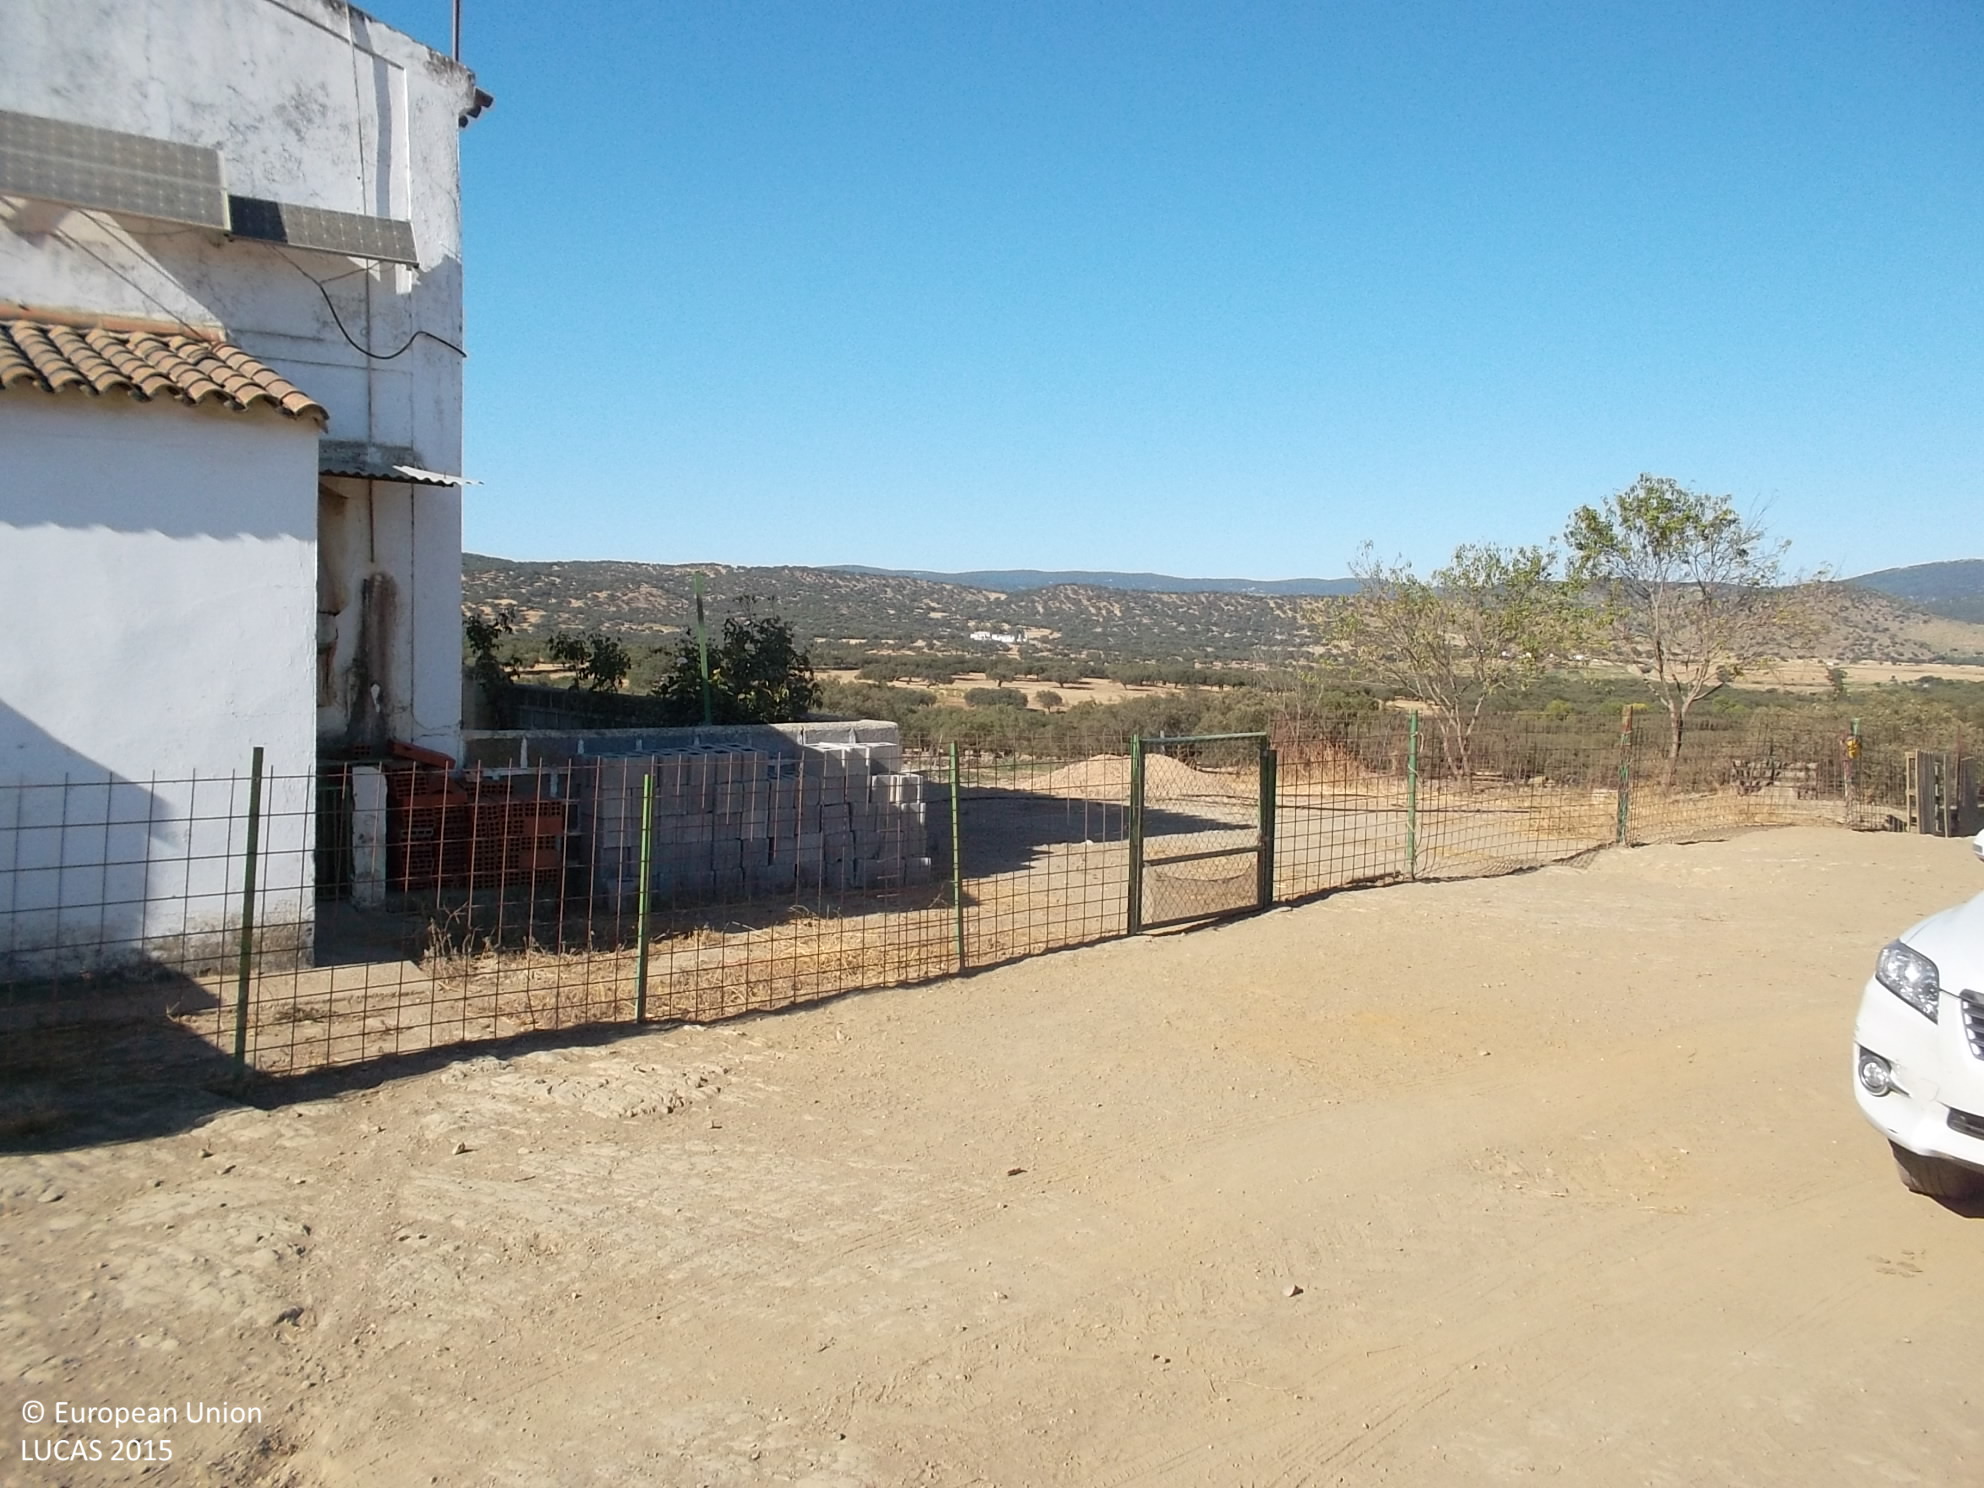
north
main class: Grassland
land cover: Spontaneously vegetated surfaces
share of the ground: > 75 %
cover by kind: herbaceous plants 100 %
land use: Fallow land
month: August
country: ES
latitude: 38.3584
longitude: -6.7291
